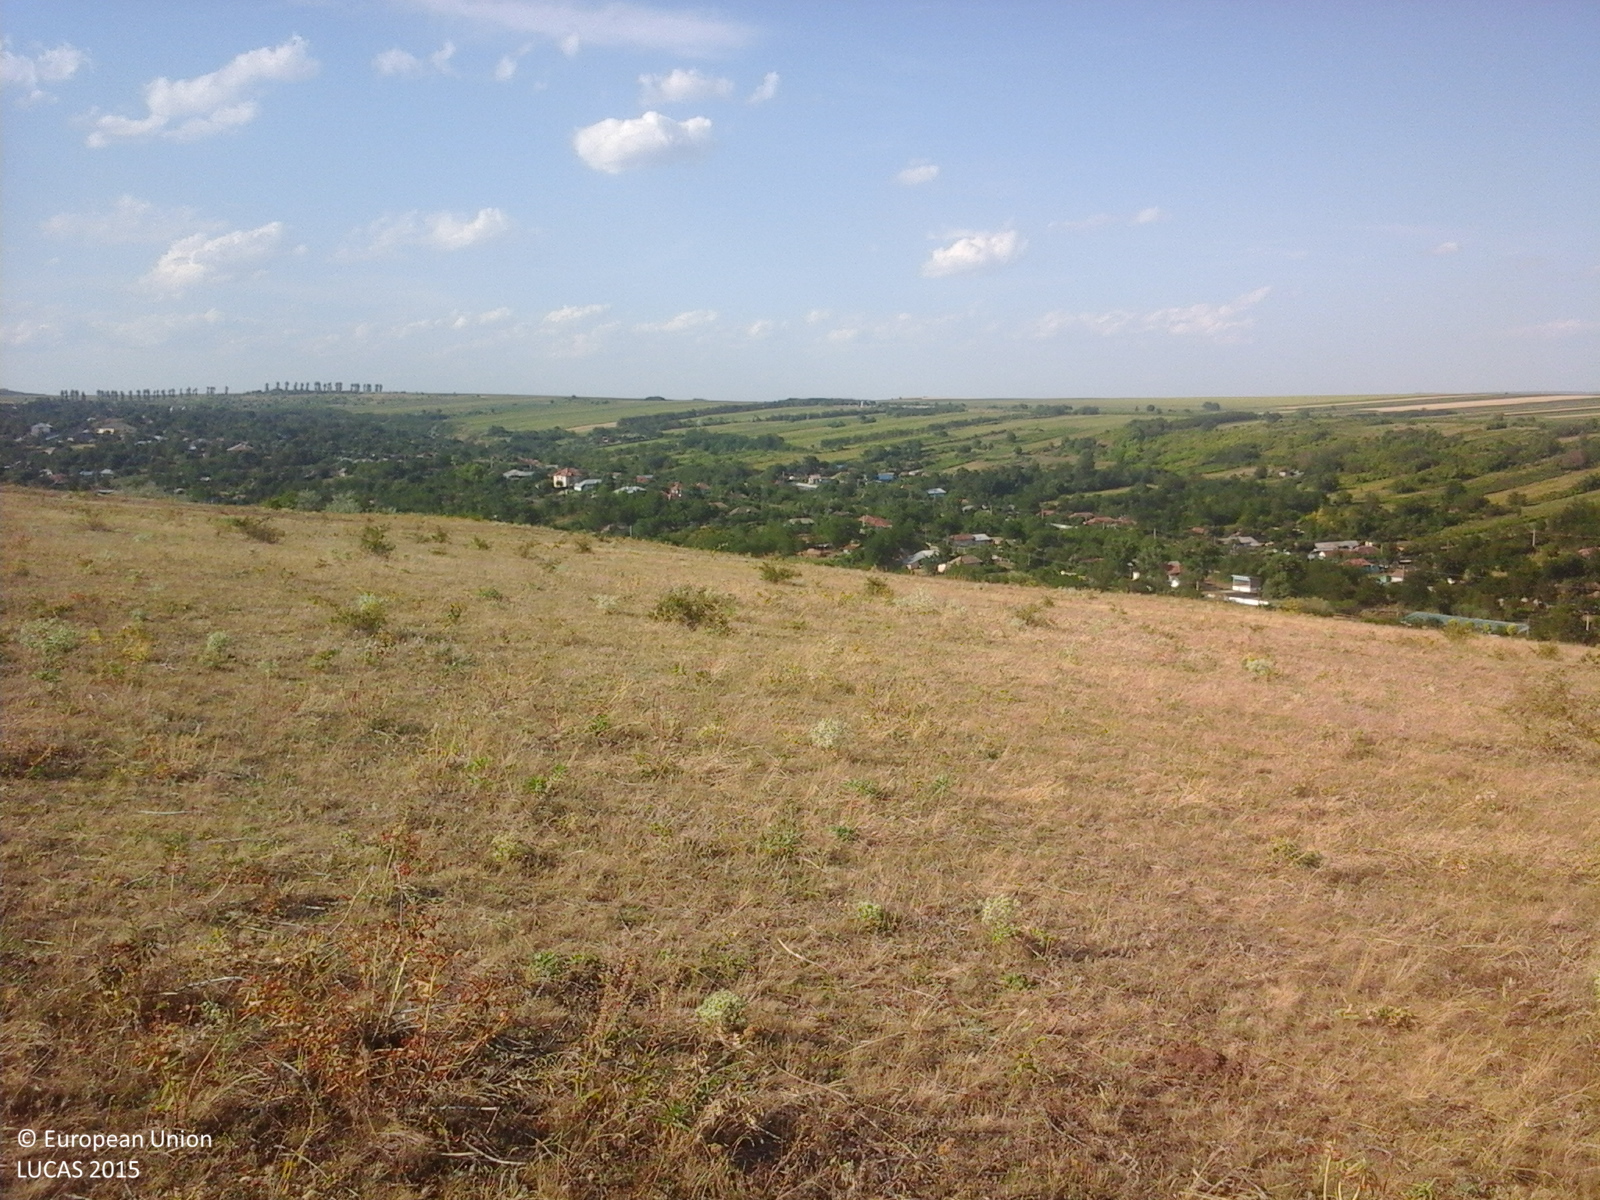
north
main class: Grassland
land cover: Spontaneously vegetated surfaces
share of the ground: > 75 %
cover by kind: herbaceous plants 100 %
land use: Fallow land
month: August
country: RO
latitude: 46.2789
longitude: 27.9144
